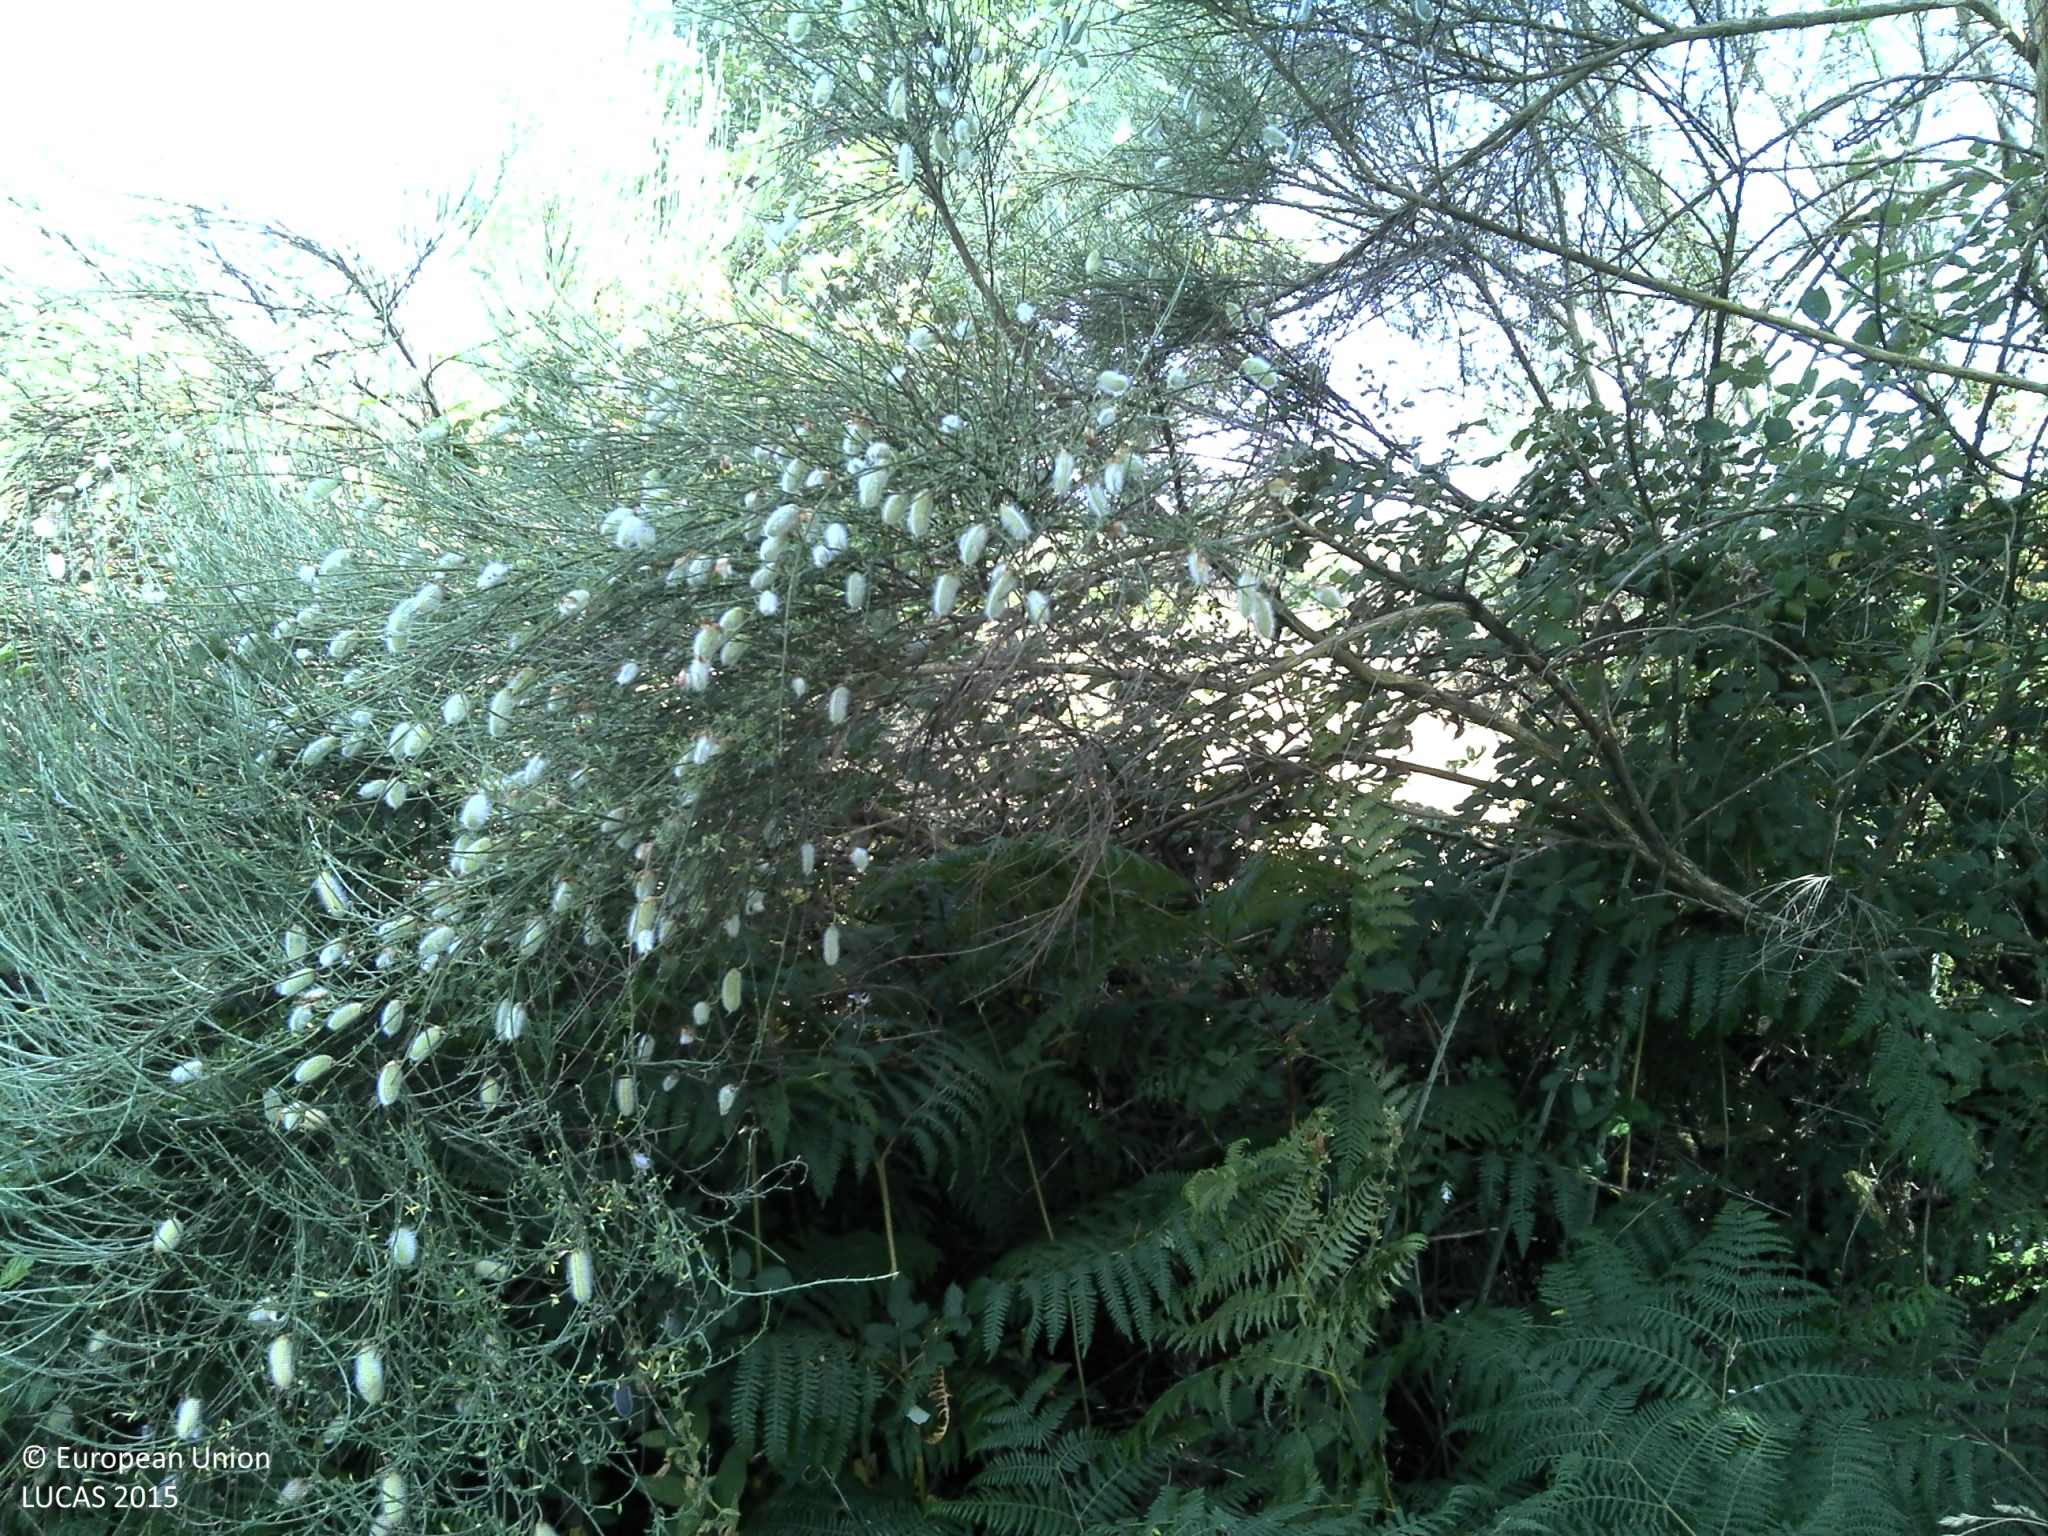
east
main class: Shrubland
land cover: Shrubland with sparse tree cover
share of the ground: 50 - 75 %
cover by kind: shrubs 55 %, unconsolidated bare surface 30 %, herbaceous plants 10 %, broadleaved forest trees 5 %
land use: Forestry
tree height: > 5 m
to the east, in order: Shrubland with sparse tree cover; Grassland with sparse tree/shrub cover; Grassland without tree/shrub cover; Grassland with sparse tree/shrub cover; Grassland without tree/shrub cover; Shrubland without tree cover; Paved roads, cycling and walking lanes; Grassland with sparse tree/shrub cover; Shrubland with sparse tree cover; Shrubland without tree cover; Rock outcrops; Shrubland without tree cover; Rocks and stones
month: July
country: PT
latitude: 40.8948
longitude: -7.6042
